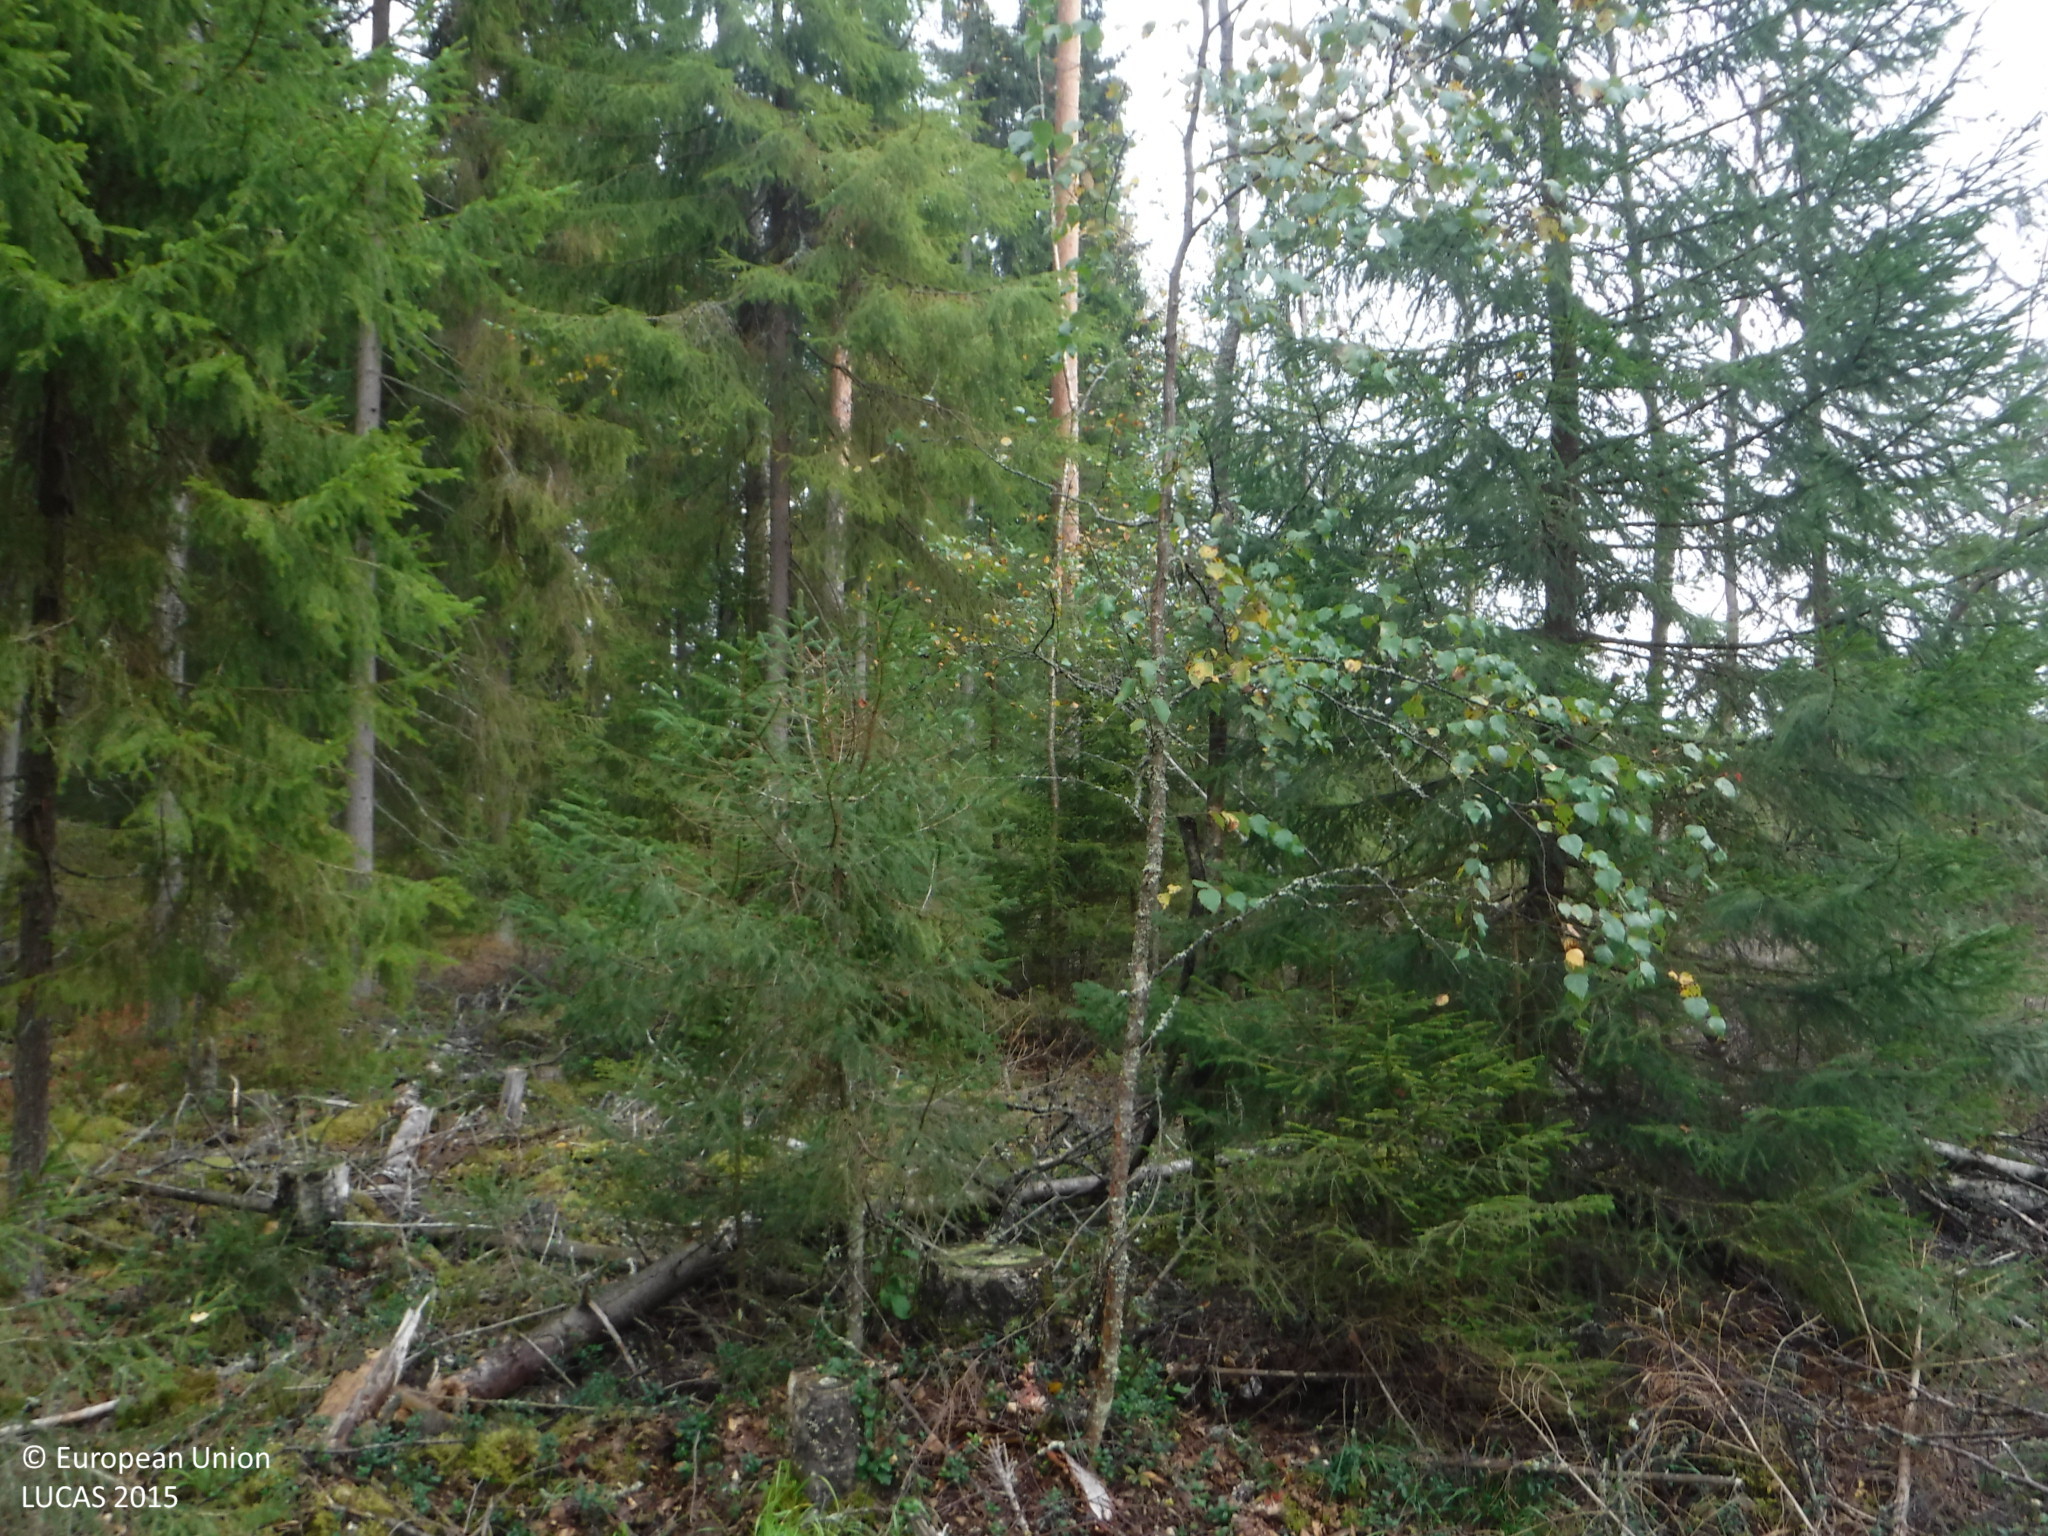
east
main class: Woodland
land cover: Spruce dominated coniferous woodland
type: boreal forest
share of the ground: 50 - 75 %
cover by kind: coniferous forest trees 50 %, lichens and mosses 20 %, herbaceous plants 10 %, unconsolidated bare surface 10 %, broadleaved forest trees 5 %
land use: Forestry
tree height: > 5 m
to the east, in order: Spruce dominated coniferous woodland; Ditches and canals; Spruce dominated coniferous woodland; Other bare soil; Spruce dominated coniferous woodland; Ditches and canals; Spruce dominated coniferous woodland; Tracks; Spruce dominated mixed woodland; Tracks; Broadleaved woodland; Spruce dominated mixed woodland; Tracks; Shrubland with sparse tree cover
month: September
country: FI
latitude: 61.5611
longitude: 23.8836
